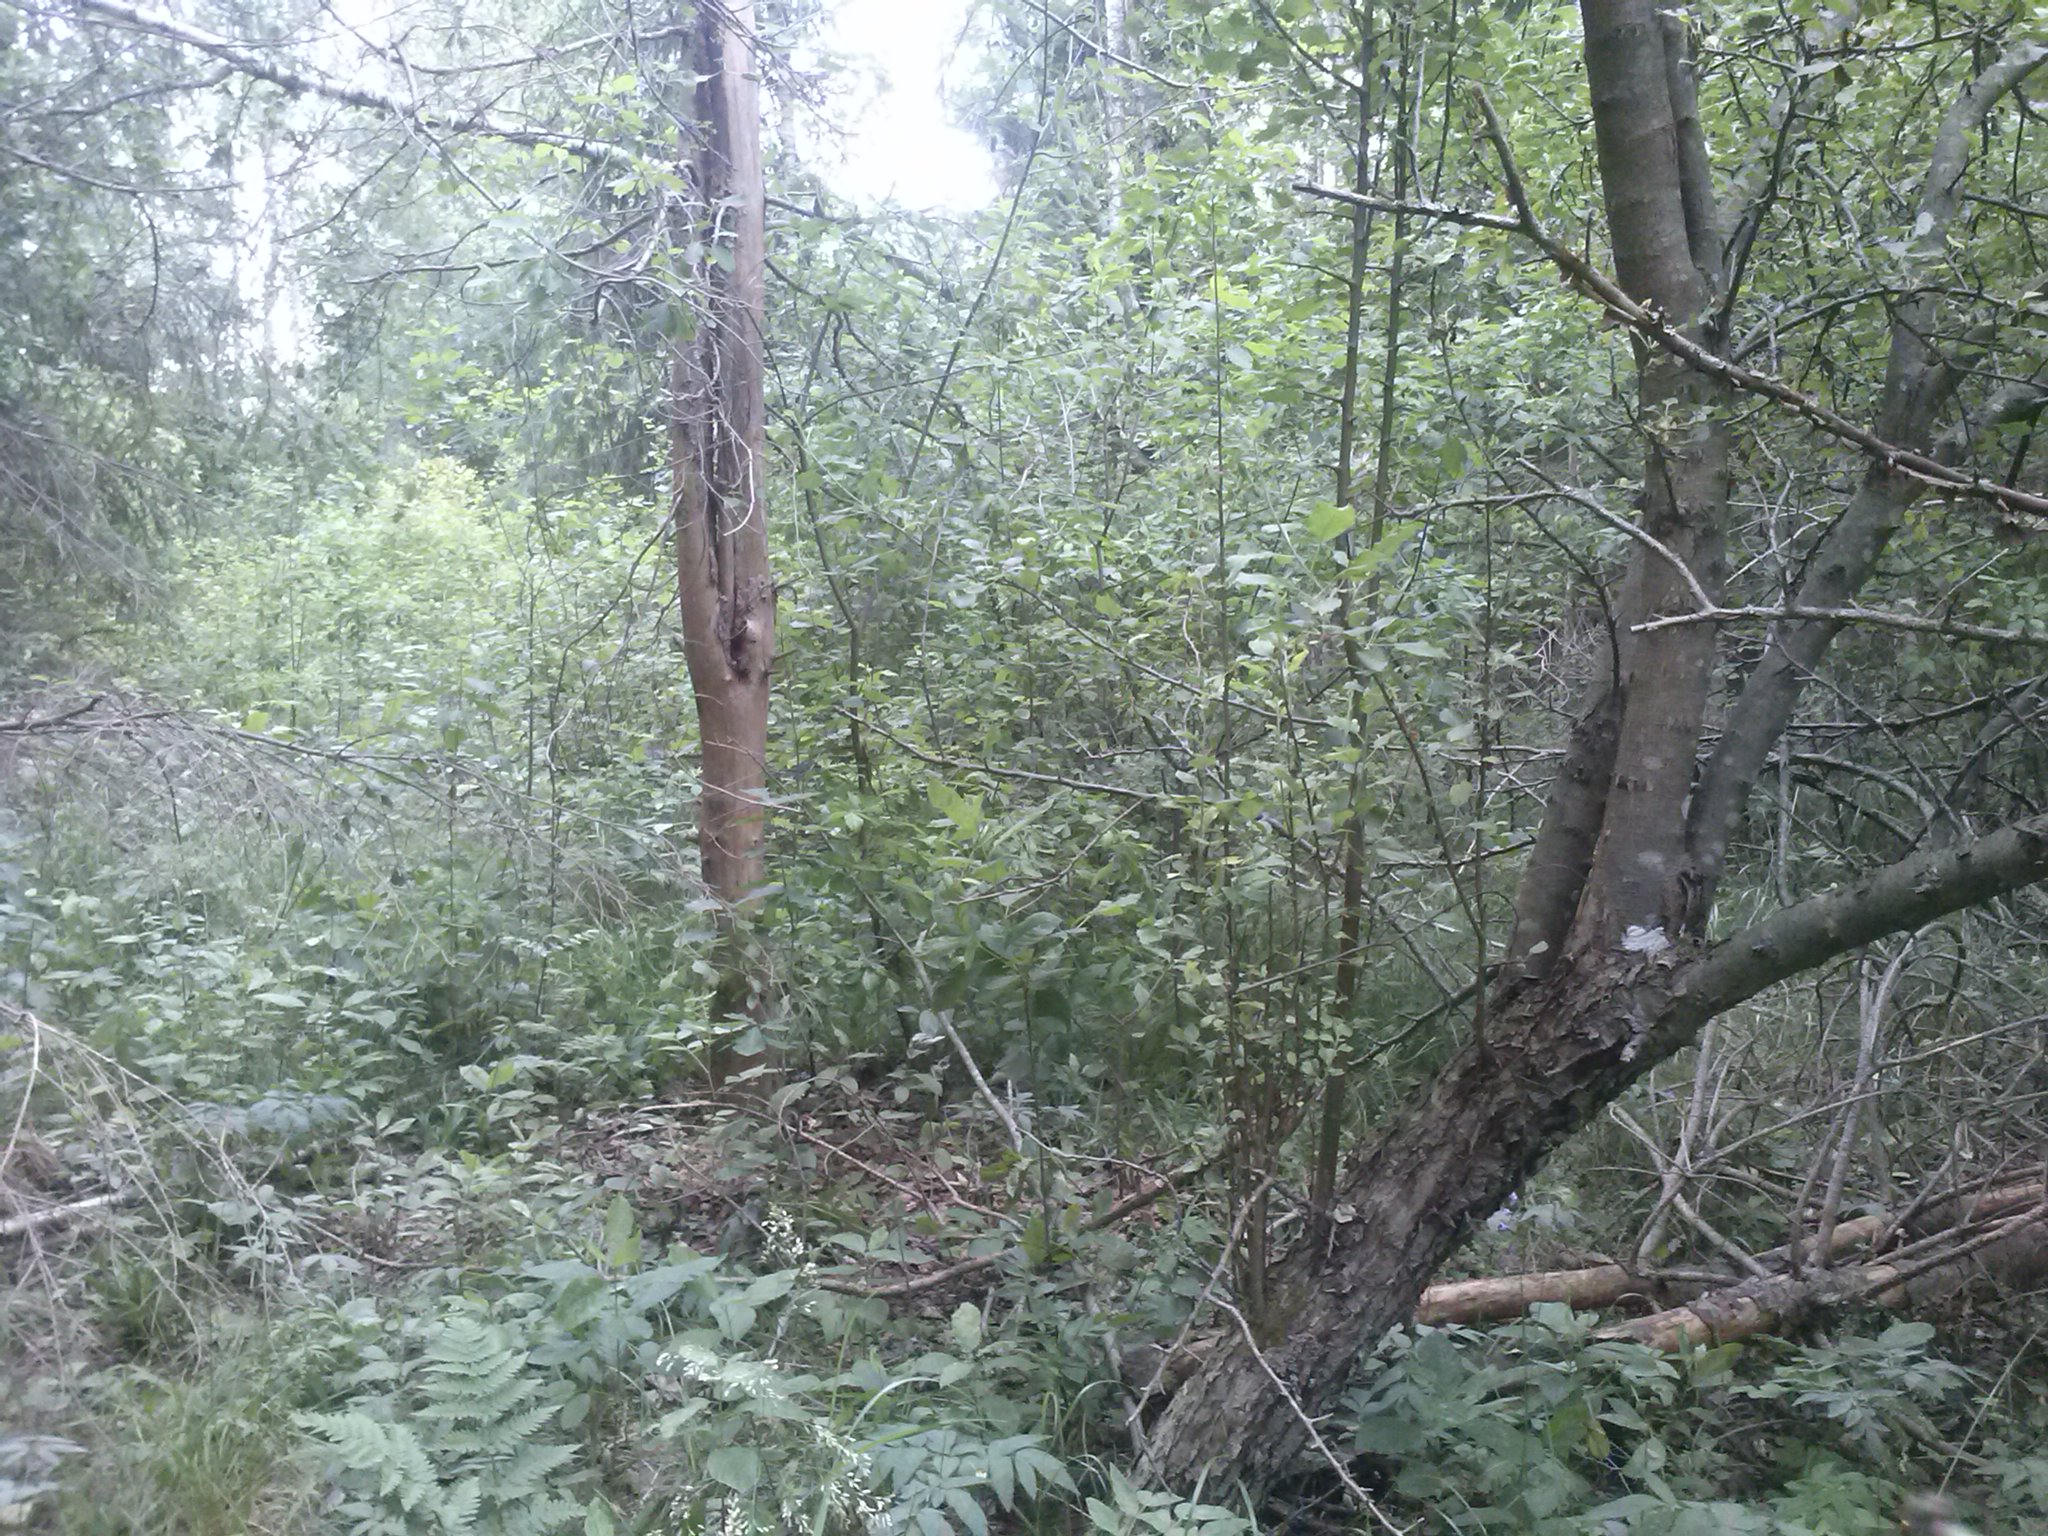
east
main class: Woodland
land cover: Broadleaved woodland
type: non-riverine alder, birch or aspen forest
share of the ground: > 75 %
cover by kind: broadleaved forest trees 80 %, shrubs 10 %, coniferous forest trees 5 %, herbaceous plants 5 %
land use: Forestry
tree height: > 5 m
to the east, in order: Broadleaved woodland; Grassland with sparse tree/shrub cover; Spontaneously vegetated surfaces; Artificial constructions in urban areas; Grassland without tree/shrub cover; Shrubland without tree cover; Spontaneously vegetated surfaces
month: July
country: LV
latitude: 56.8304
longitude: 27.3982
